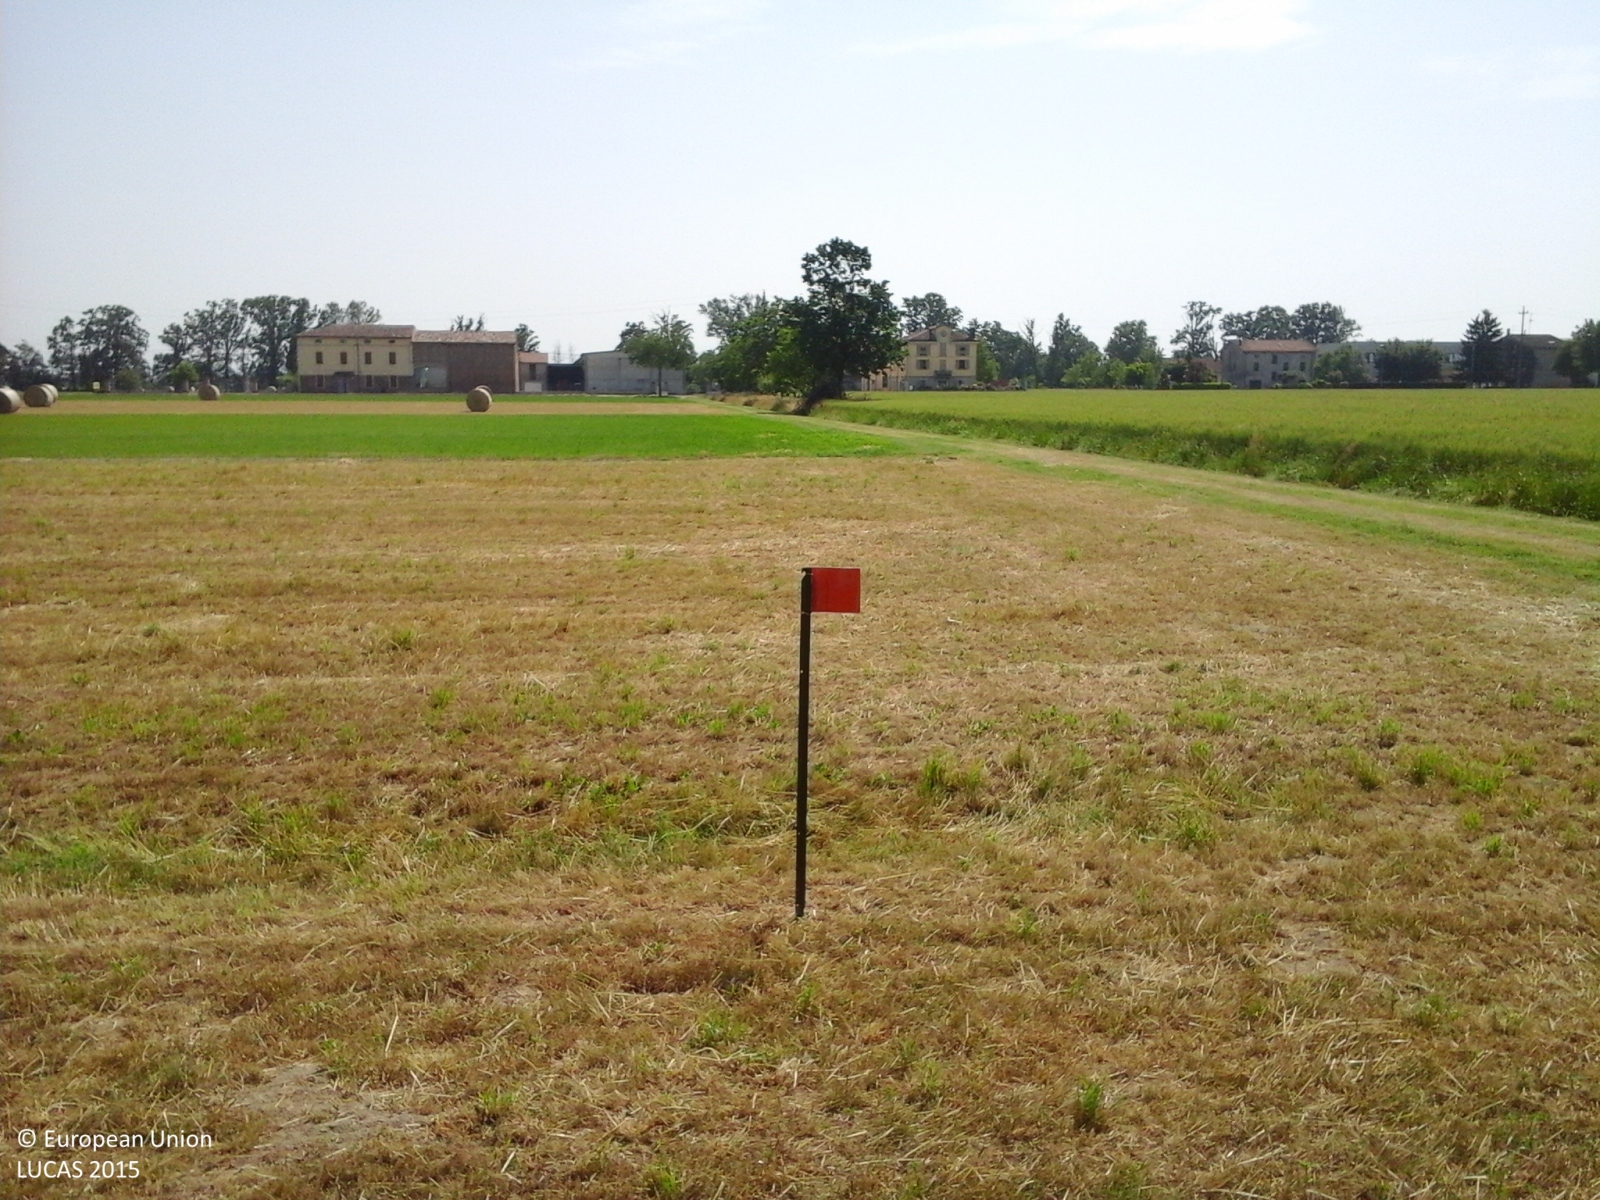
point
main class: Cropland
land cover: Lucerne
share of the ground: > 75 %
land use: Agriculture (excluding fallow land and kitchen gardens)
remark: Harvested field
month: May
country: IT
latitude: 44.9092
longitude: 10.2654
